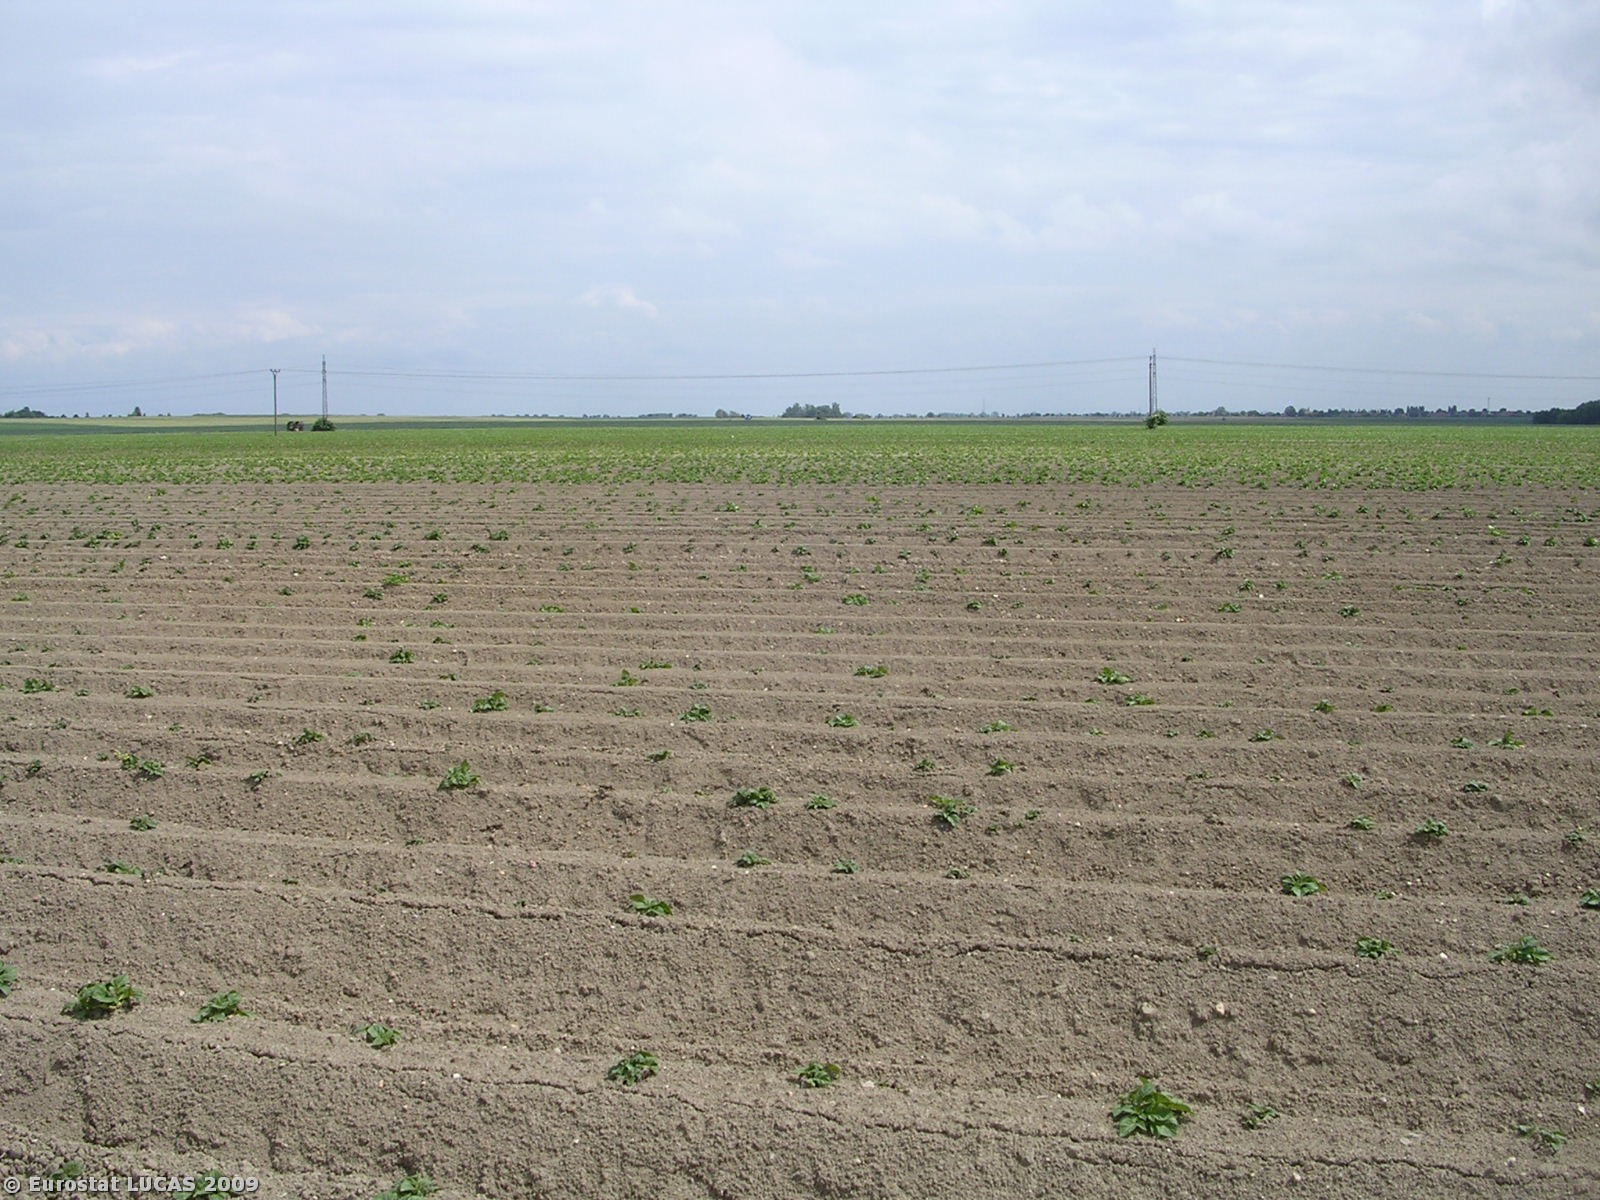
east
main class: Cropland
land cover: Potatoes
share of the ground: 10 - 25 %
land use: Agriculture (excluding fallow land and kitchen gardens)
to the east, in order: Potatoes
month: May
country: CZ
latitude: 50.2066
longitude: 14.8644
